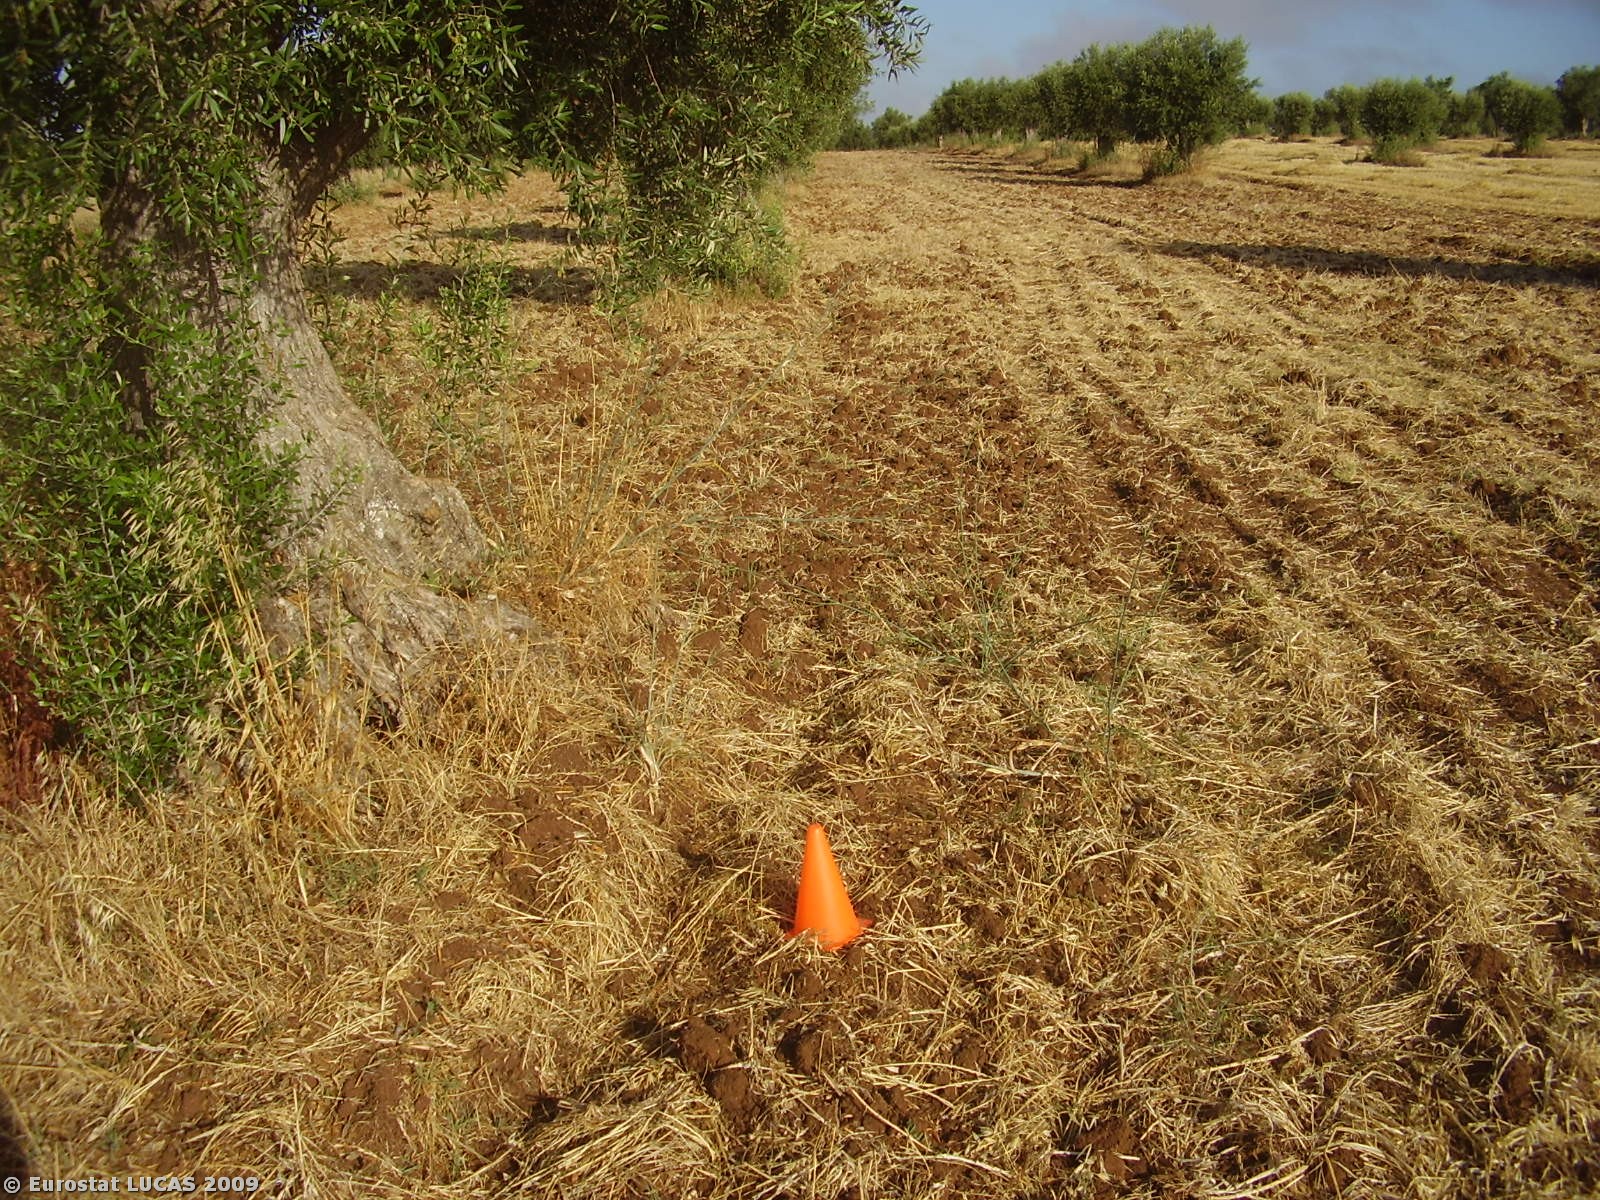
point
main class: Cropland
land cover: Olive groves
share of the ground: 10 - 25 %
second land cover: Oats
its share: > 75 %
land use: Agriculture (excluding fallow land and kitchen gardens)
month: August
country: PT
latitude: 38.0762
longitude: -7.9631
